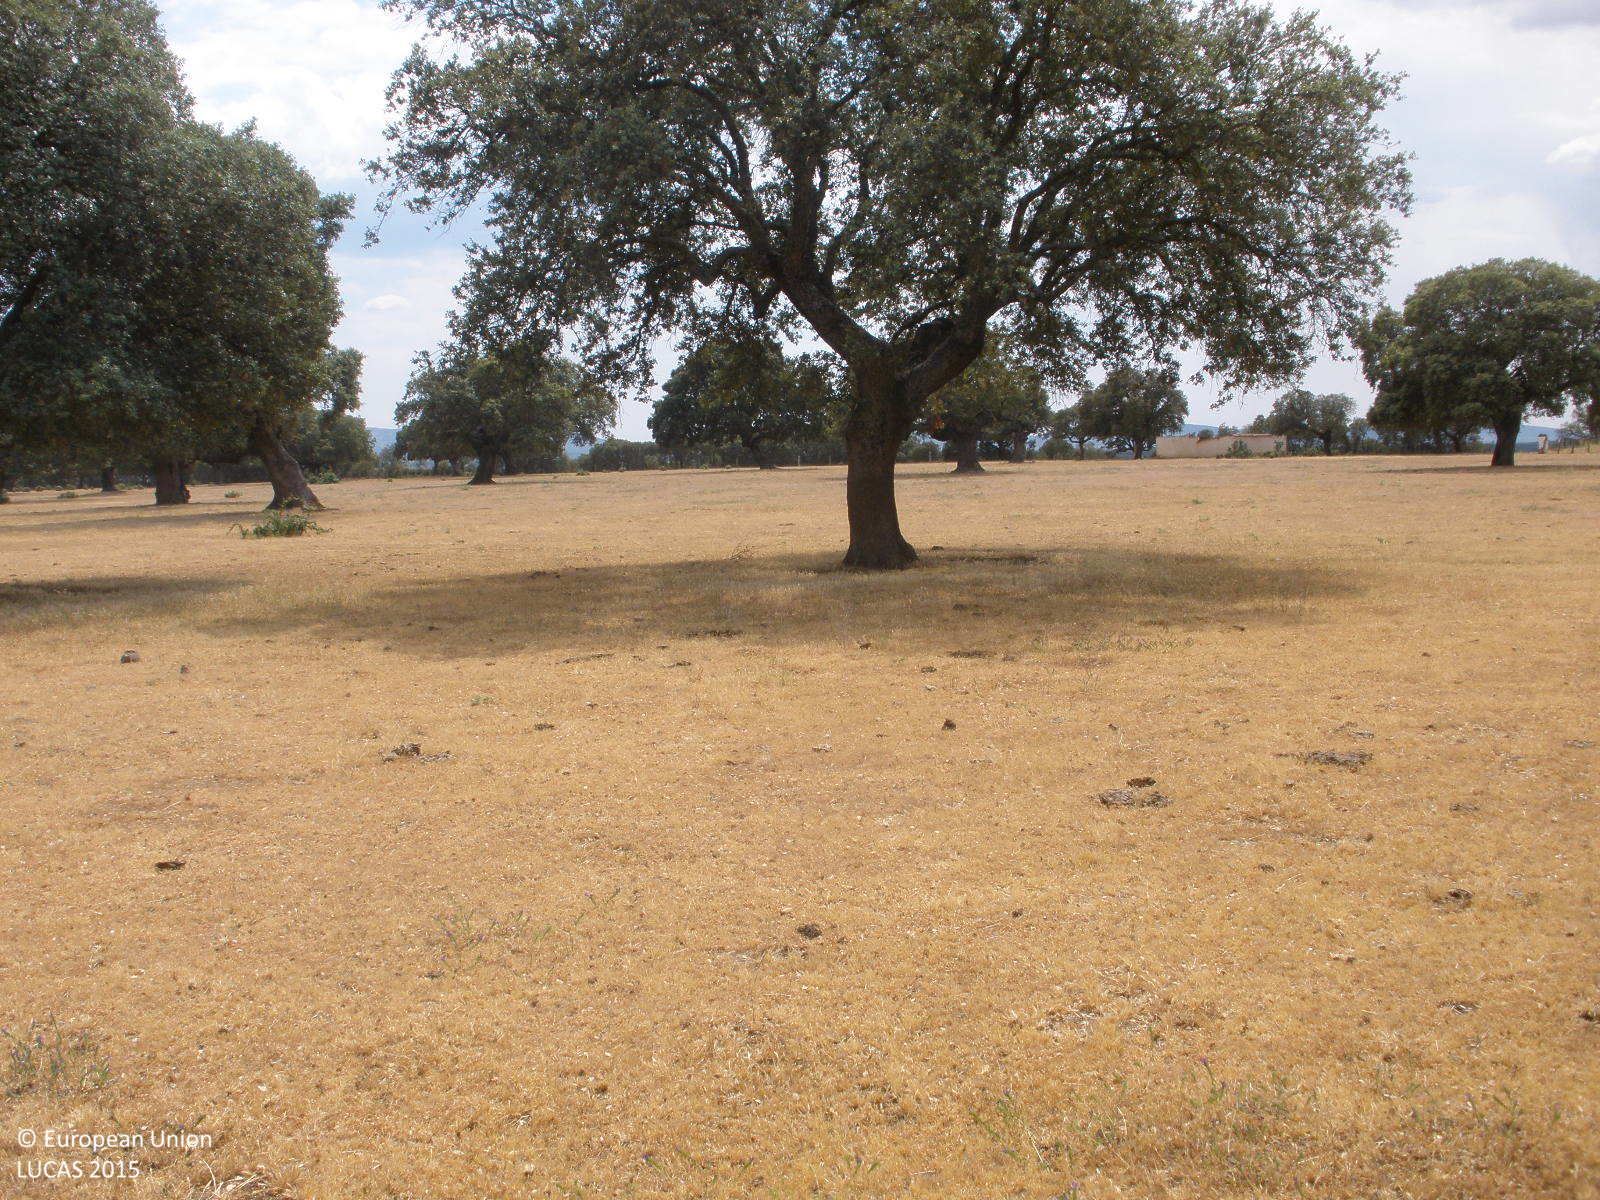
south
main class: Woodland
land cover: Broadleaved woodland
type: broadleaved evergreen forest
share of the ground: 10 - 25 %
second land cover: Grassland without tree/shrub cover
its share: > 75 %
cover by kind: herbaceous plants 90 %, broadleaved forest trees 10 %
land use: Forestry
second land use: Agriculture (excluding fallow land and kitchen gardens)
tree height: > 5 m
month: June
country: ES
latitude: 40.6723
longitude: -6.2325
